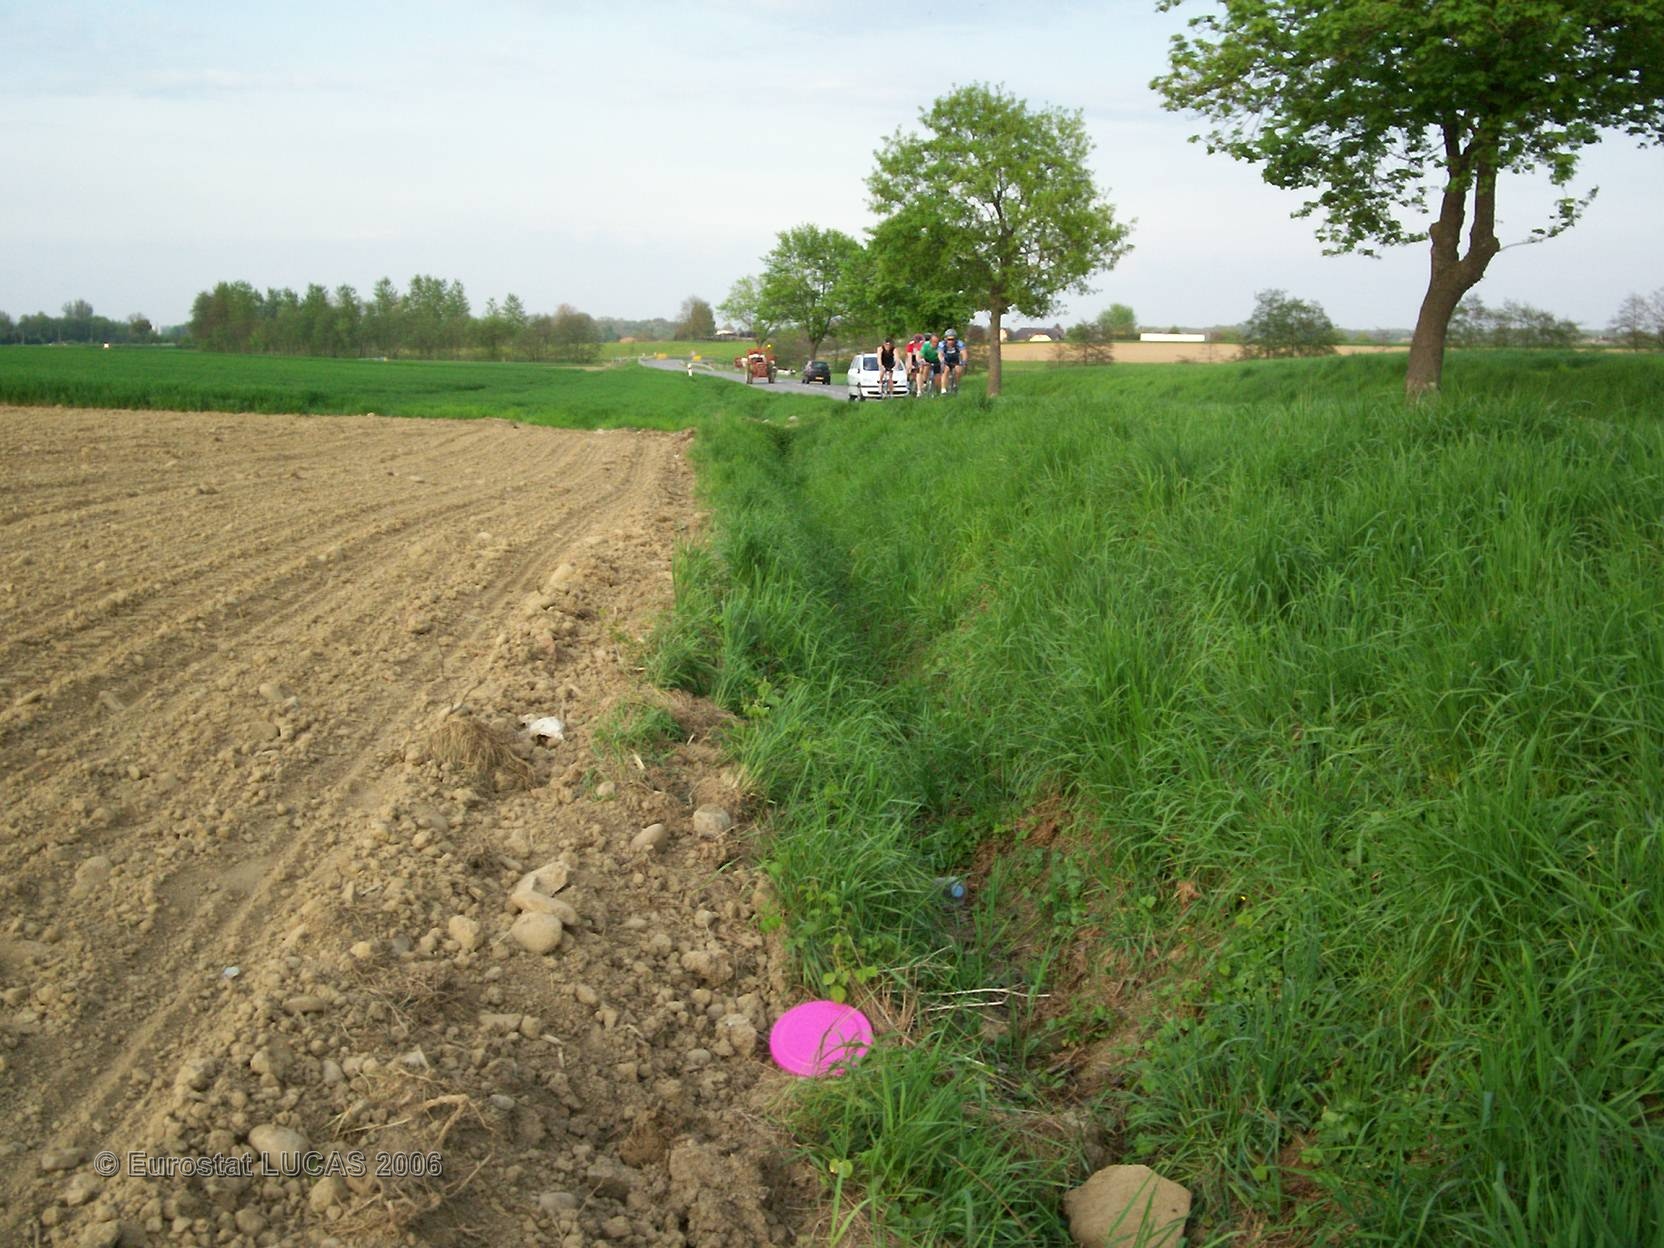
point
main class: Cropland
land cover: Maize
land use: Agriculture (excluding fallow land and kitchen gardens)
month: May
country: FR
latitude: 47.6462
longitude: 7.1395
